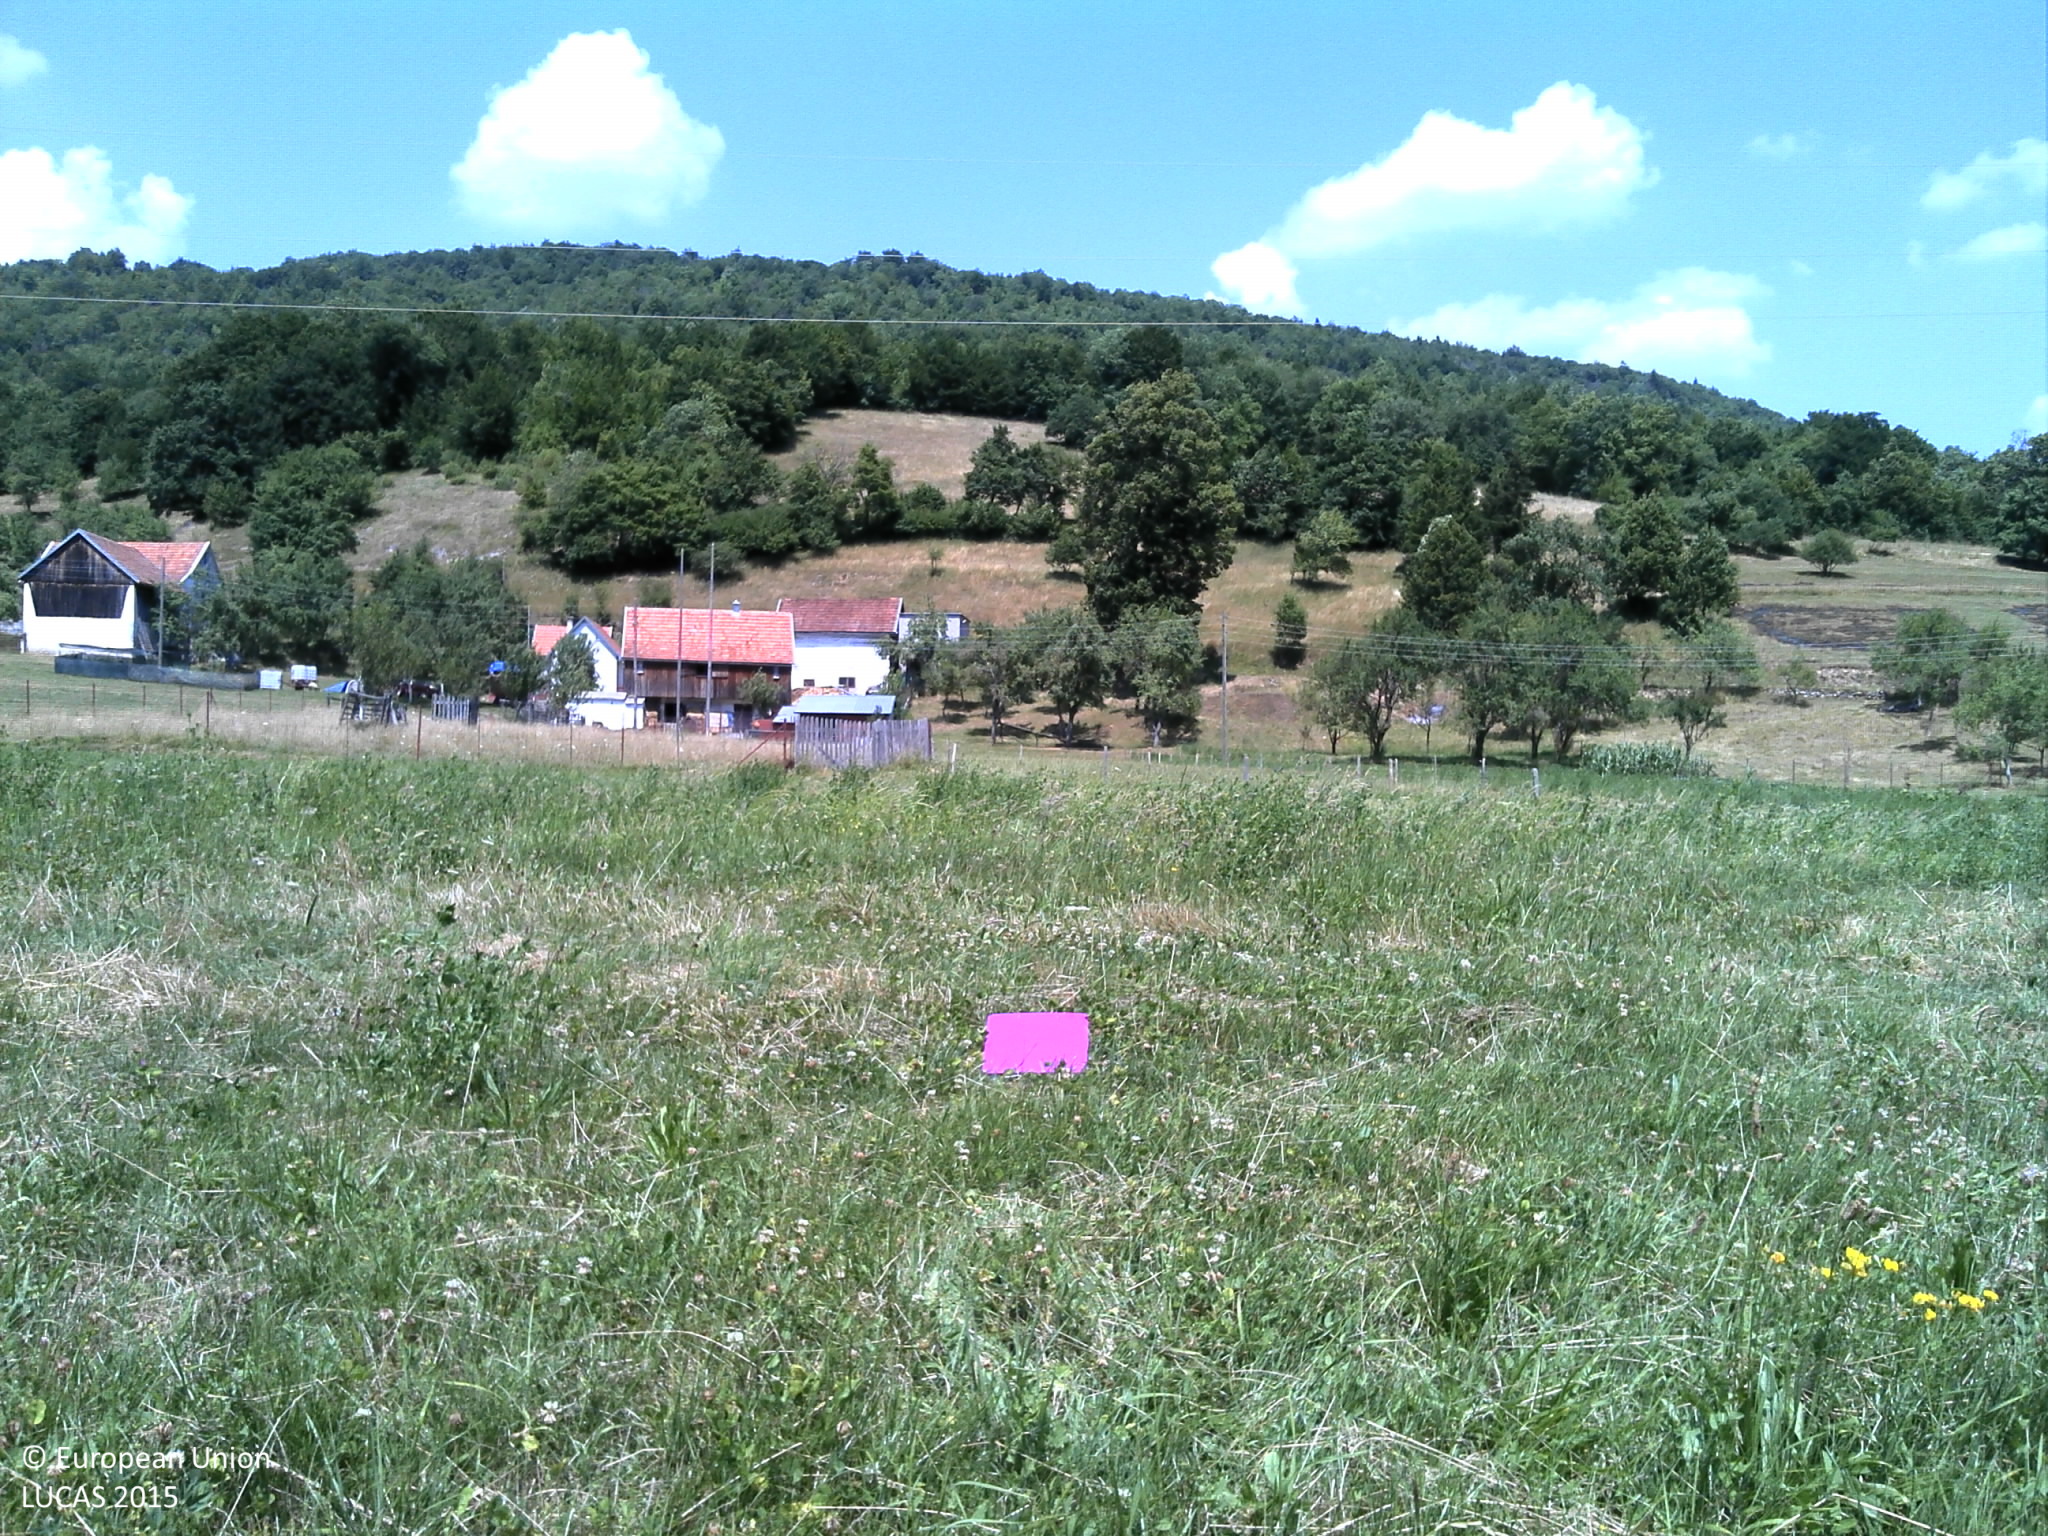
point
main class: Grassland
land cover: Grassland without tree/shrub cover
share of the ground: > 75 %
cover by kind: herbaceous plants 100 %
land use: Agriculture (excluding fallow land and kitchen gardens)
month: July
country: HR
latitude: 44.9774
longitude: 15.2317
